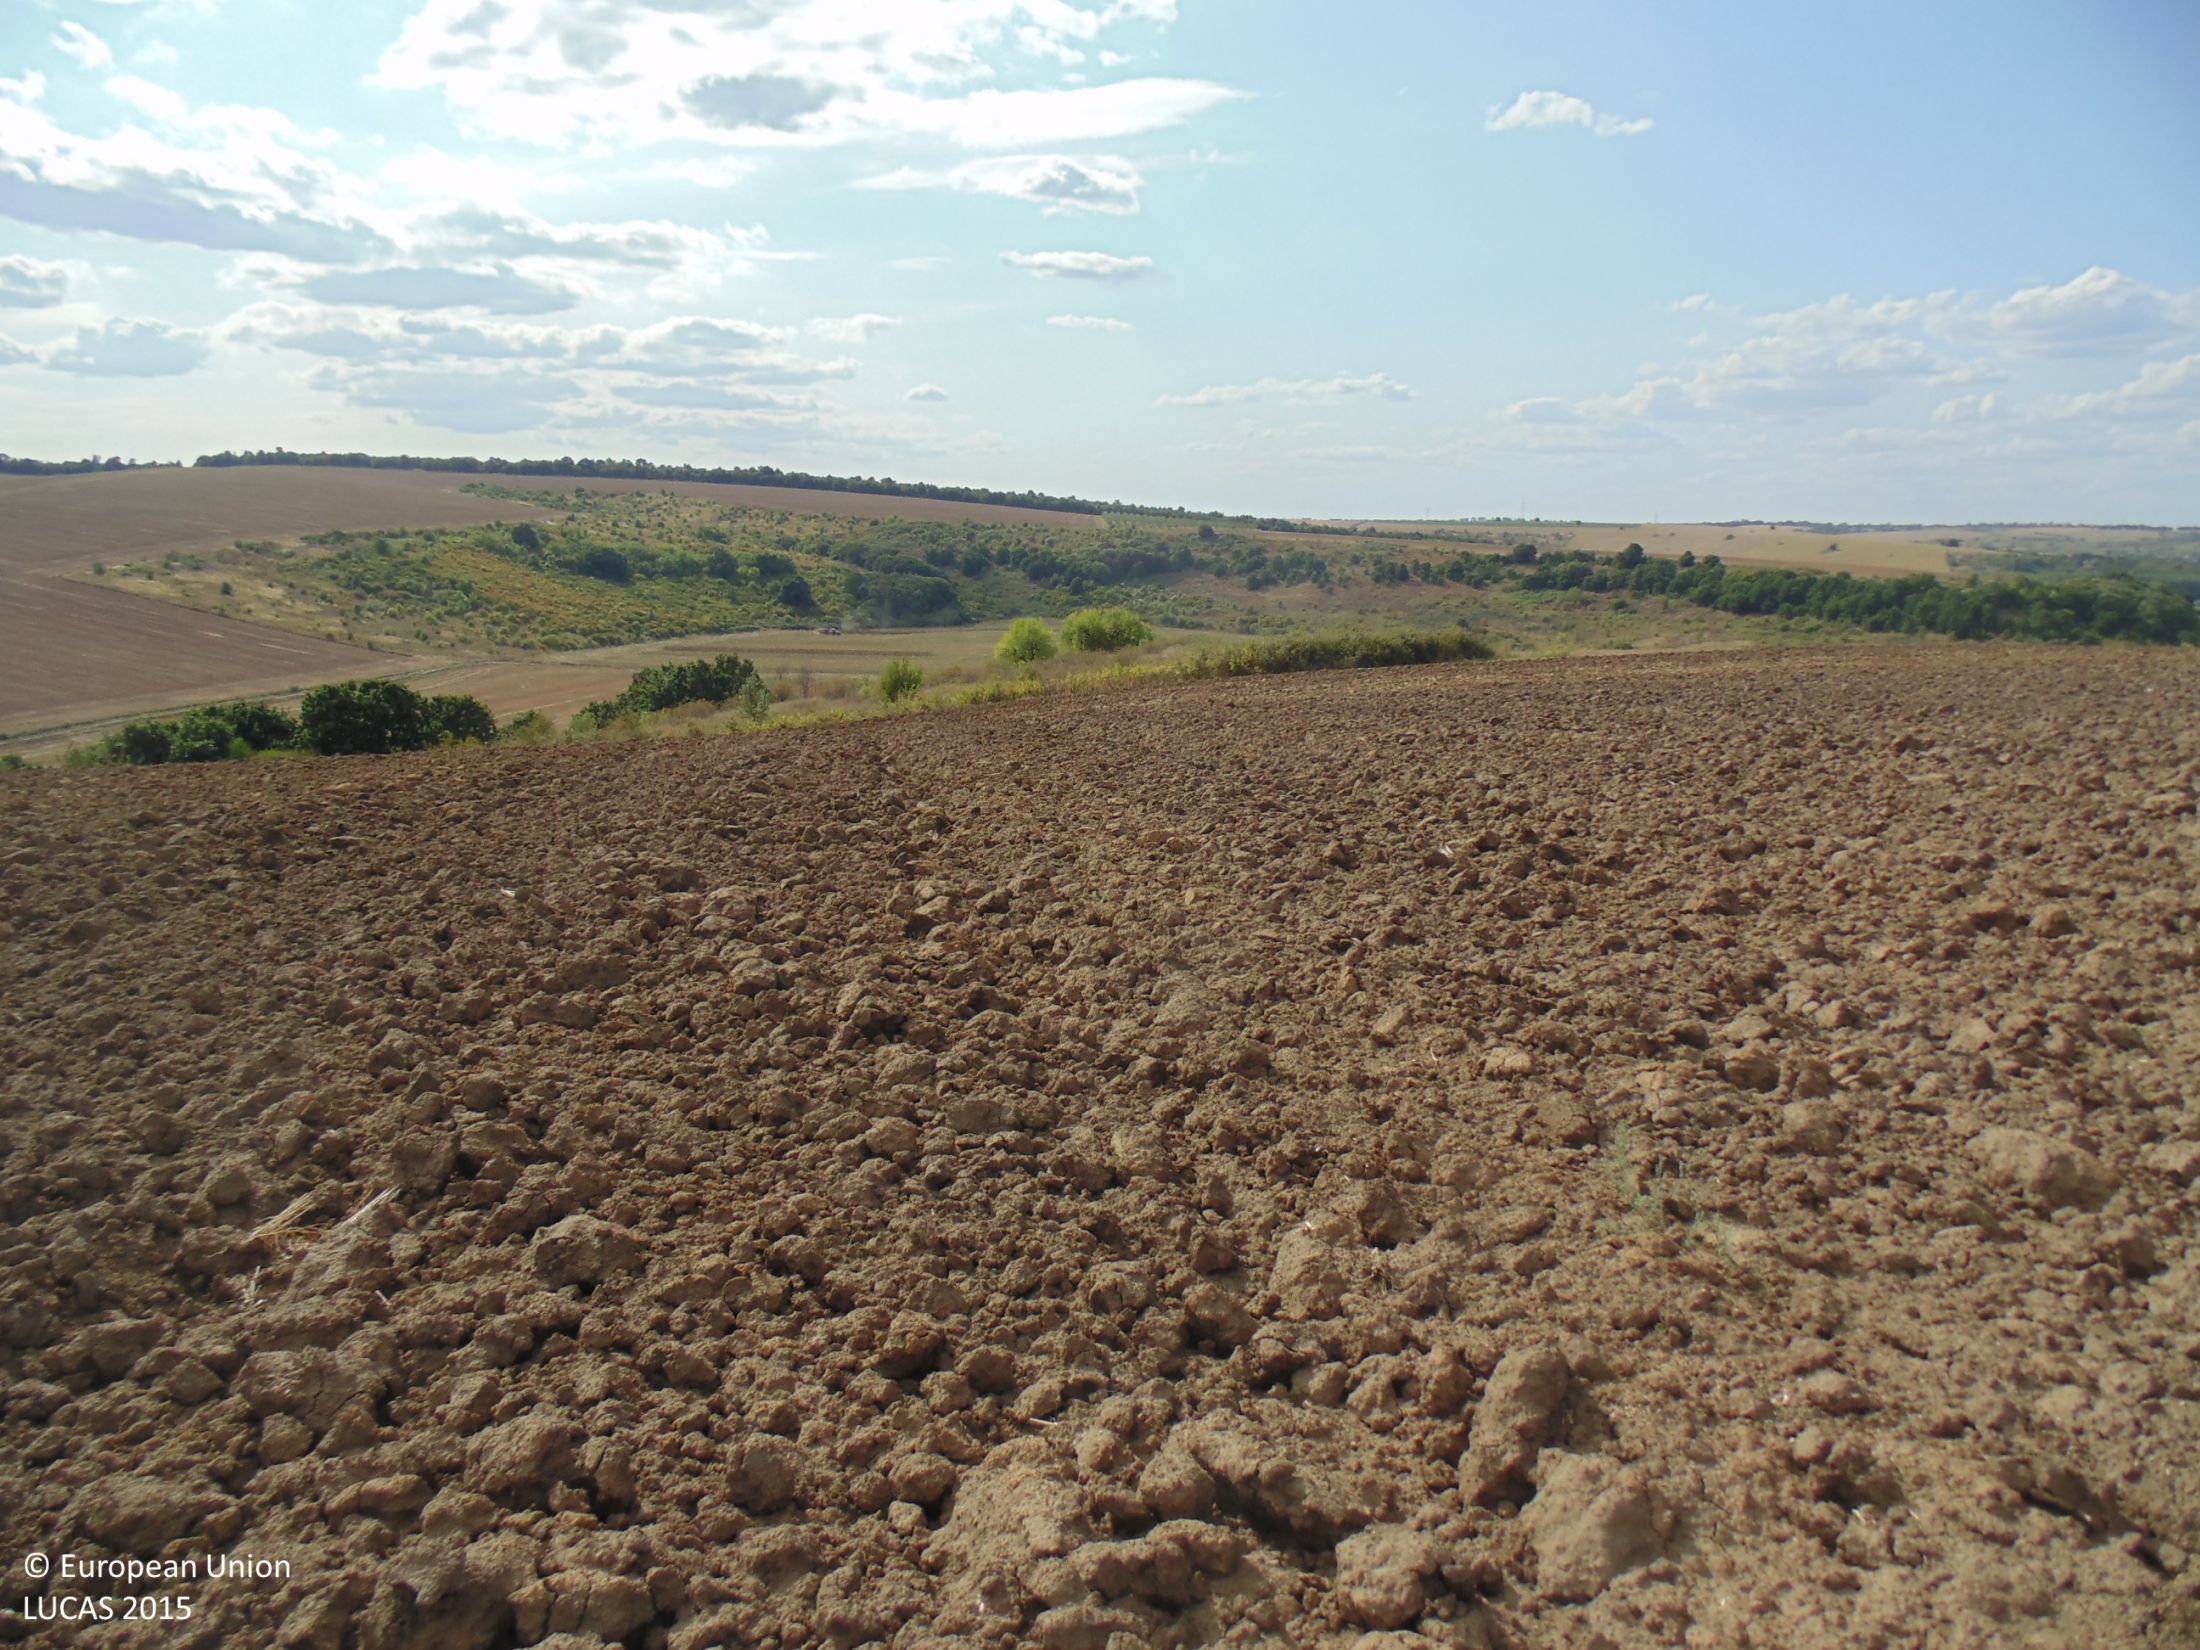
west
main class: Cropland
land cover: Common wheat
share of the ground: < 10 %
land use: Agriculture (excluding fallow land and kitchen gardens)
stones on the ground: < 10 %
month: September
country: BG
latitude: 44.0783
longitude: 27.0970
